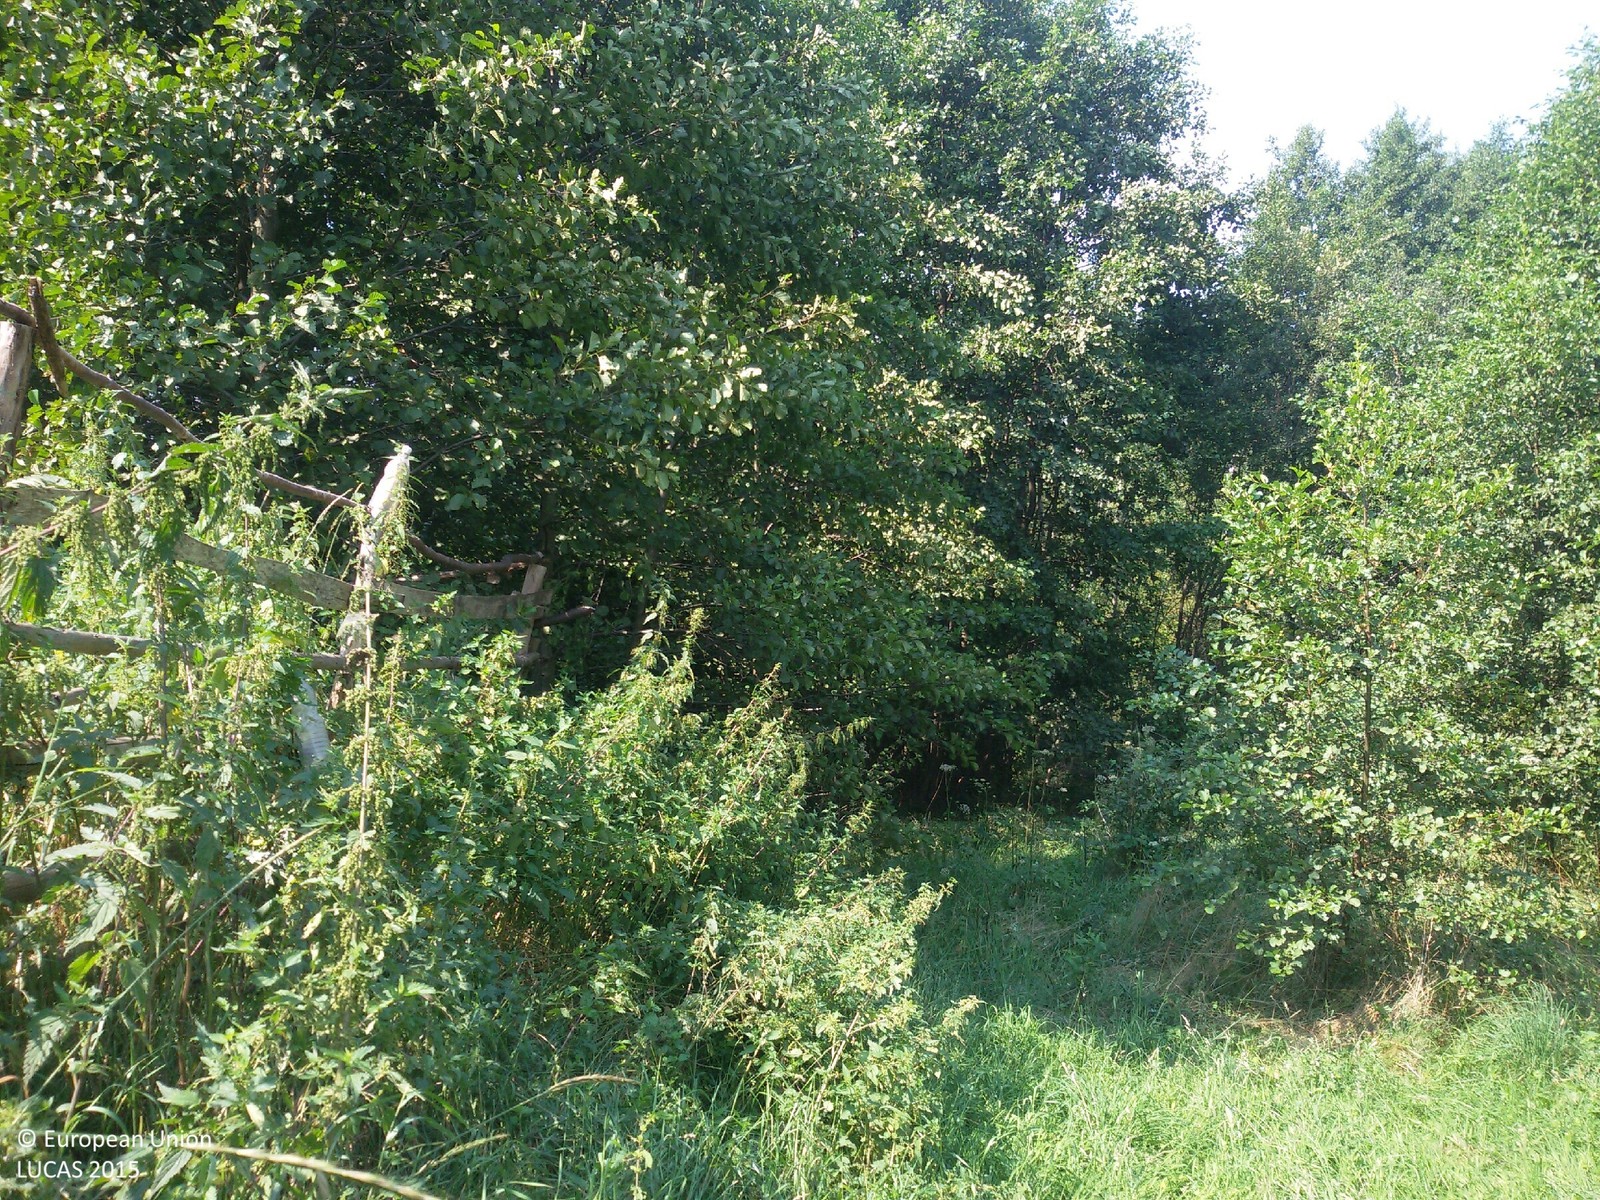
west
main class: Woodland
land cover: Broadleaved woodland
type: mesophytic deciduous forest
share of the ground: > 75 %
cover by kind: broadleaved forest trees 100 %
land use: Semi-natural and natural areas not in use
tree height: > 5 m
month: August
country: PL
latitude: 51.0697
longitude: 20.9613
